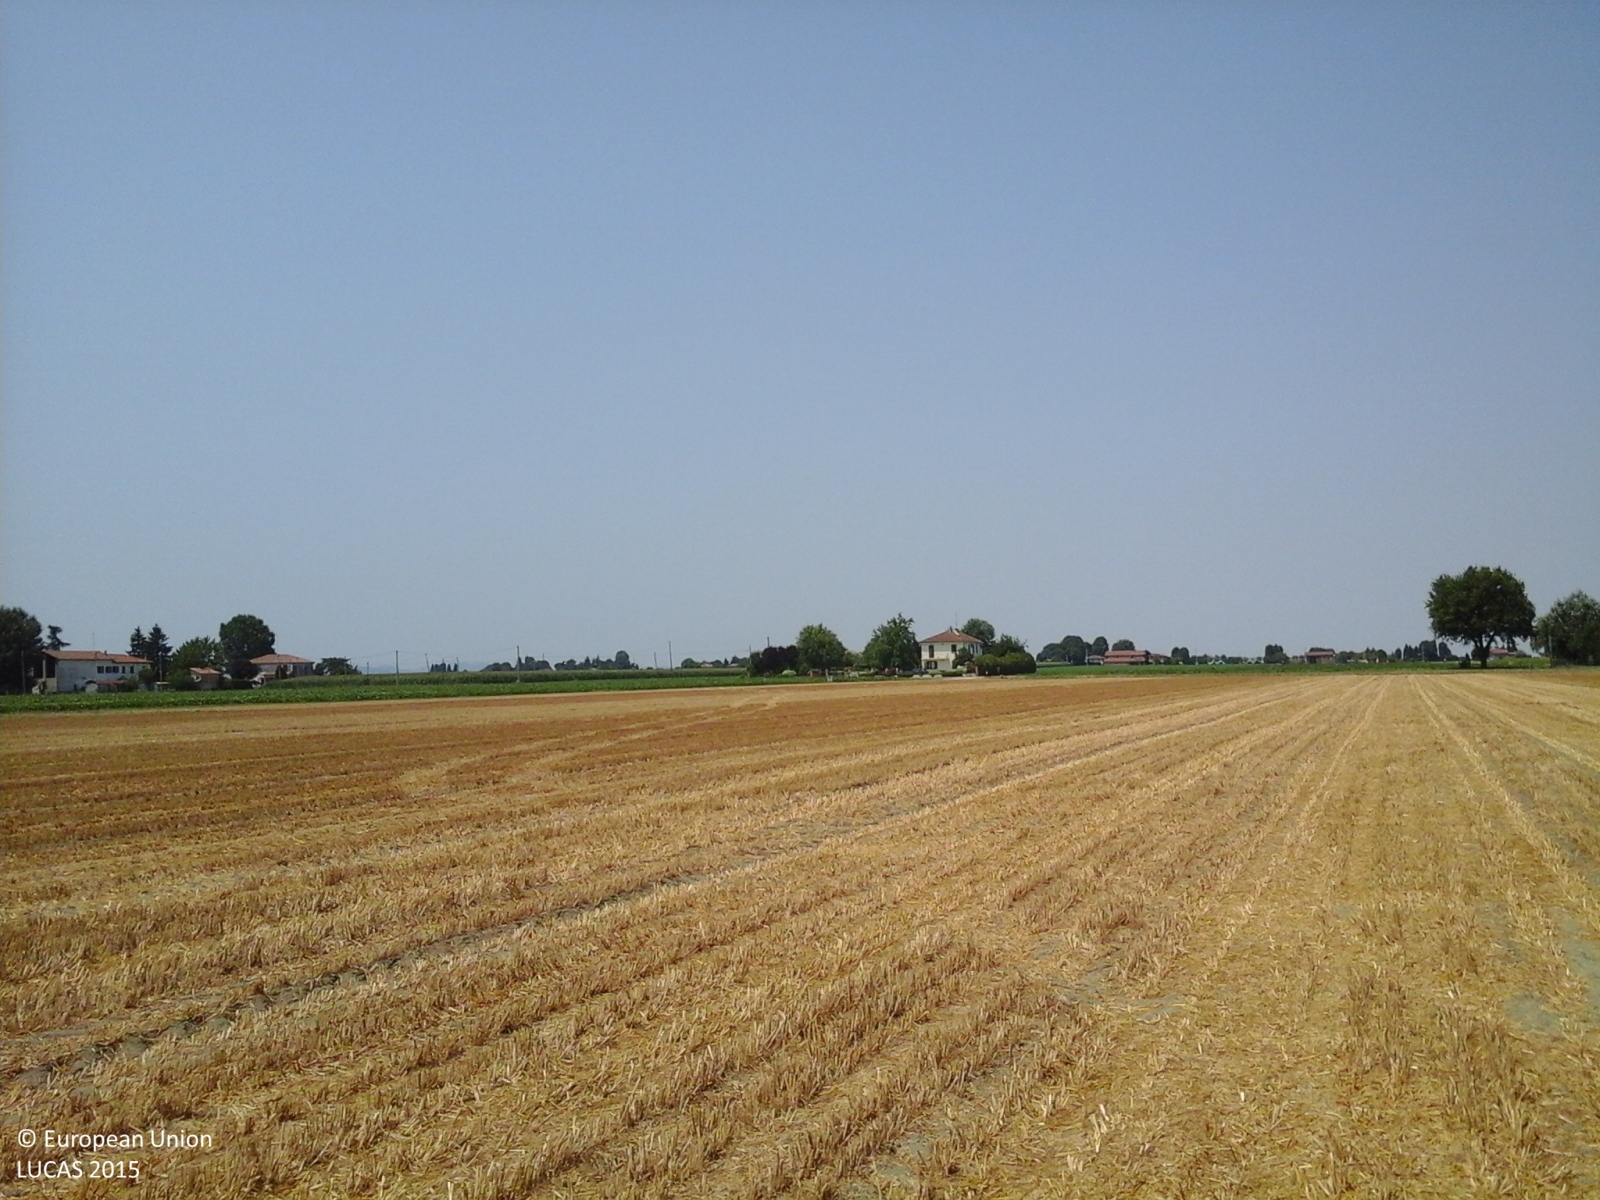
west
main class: Cropland
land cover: Common wheat
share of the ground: > 75 %
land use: Agriculture (excluding fallow land and kitchen gardens)
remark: Harvested field
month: July
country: IT
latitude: 44.4450
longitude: 11.6926
